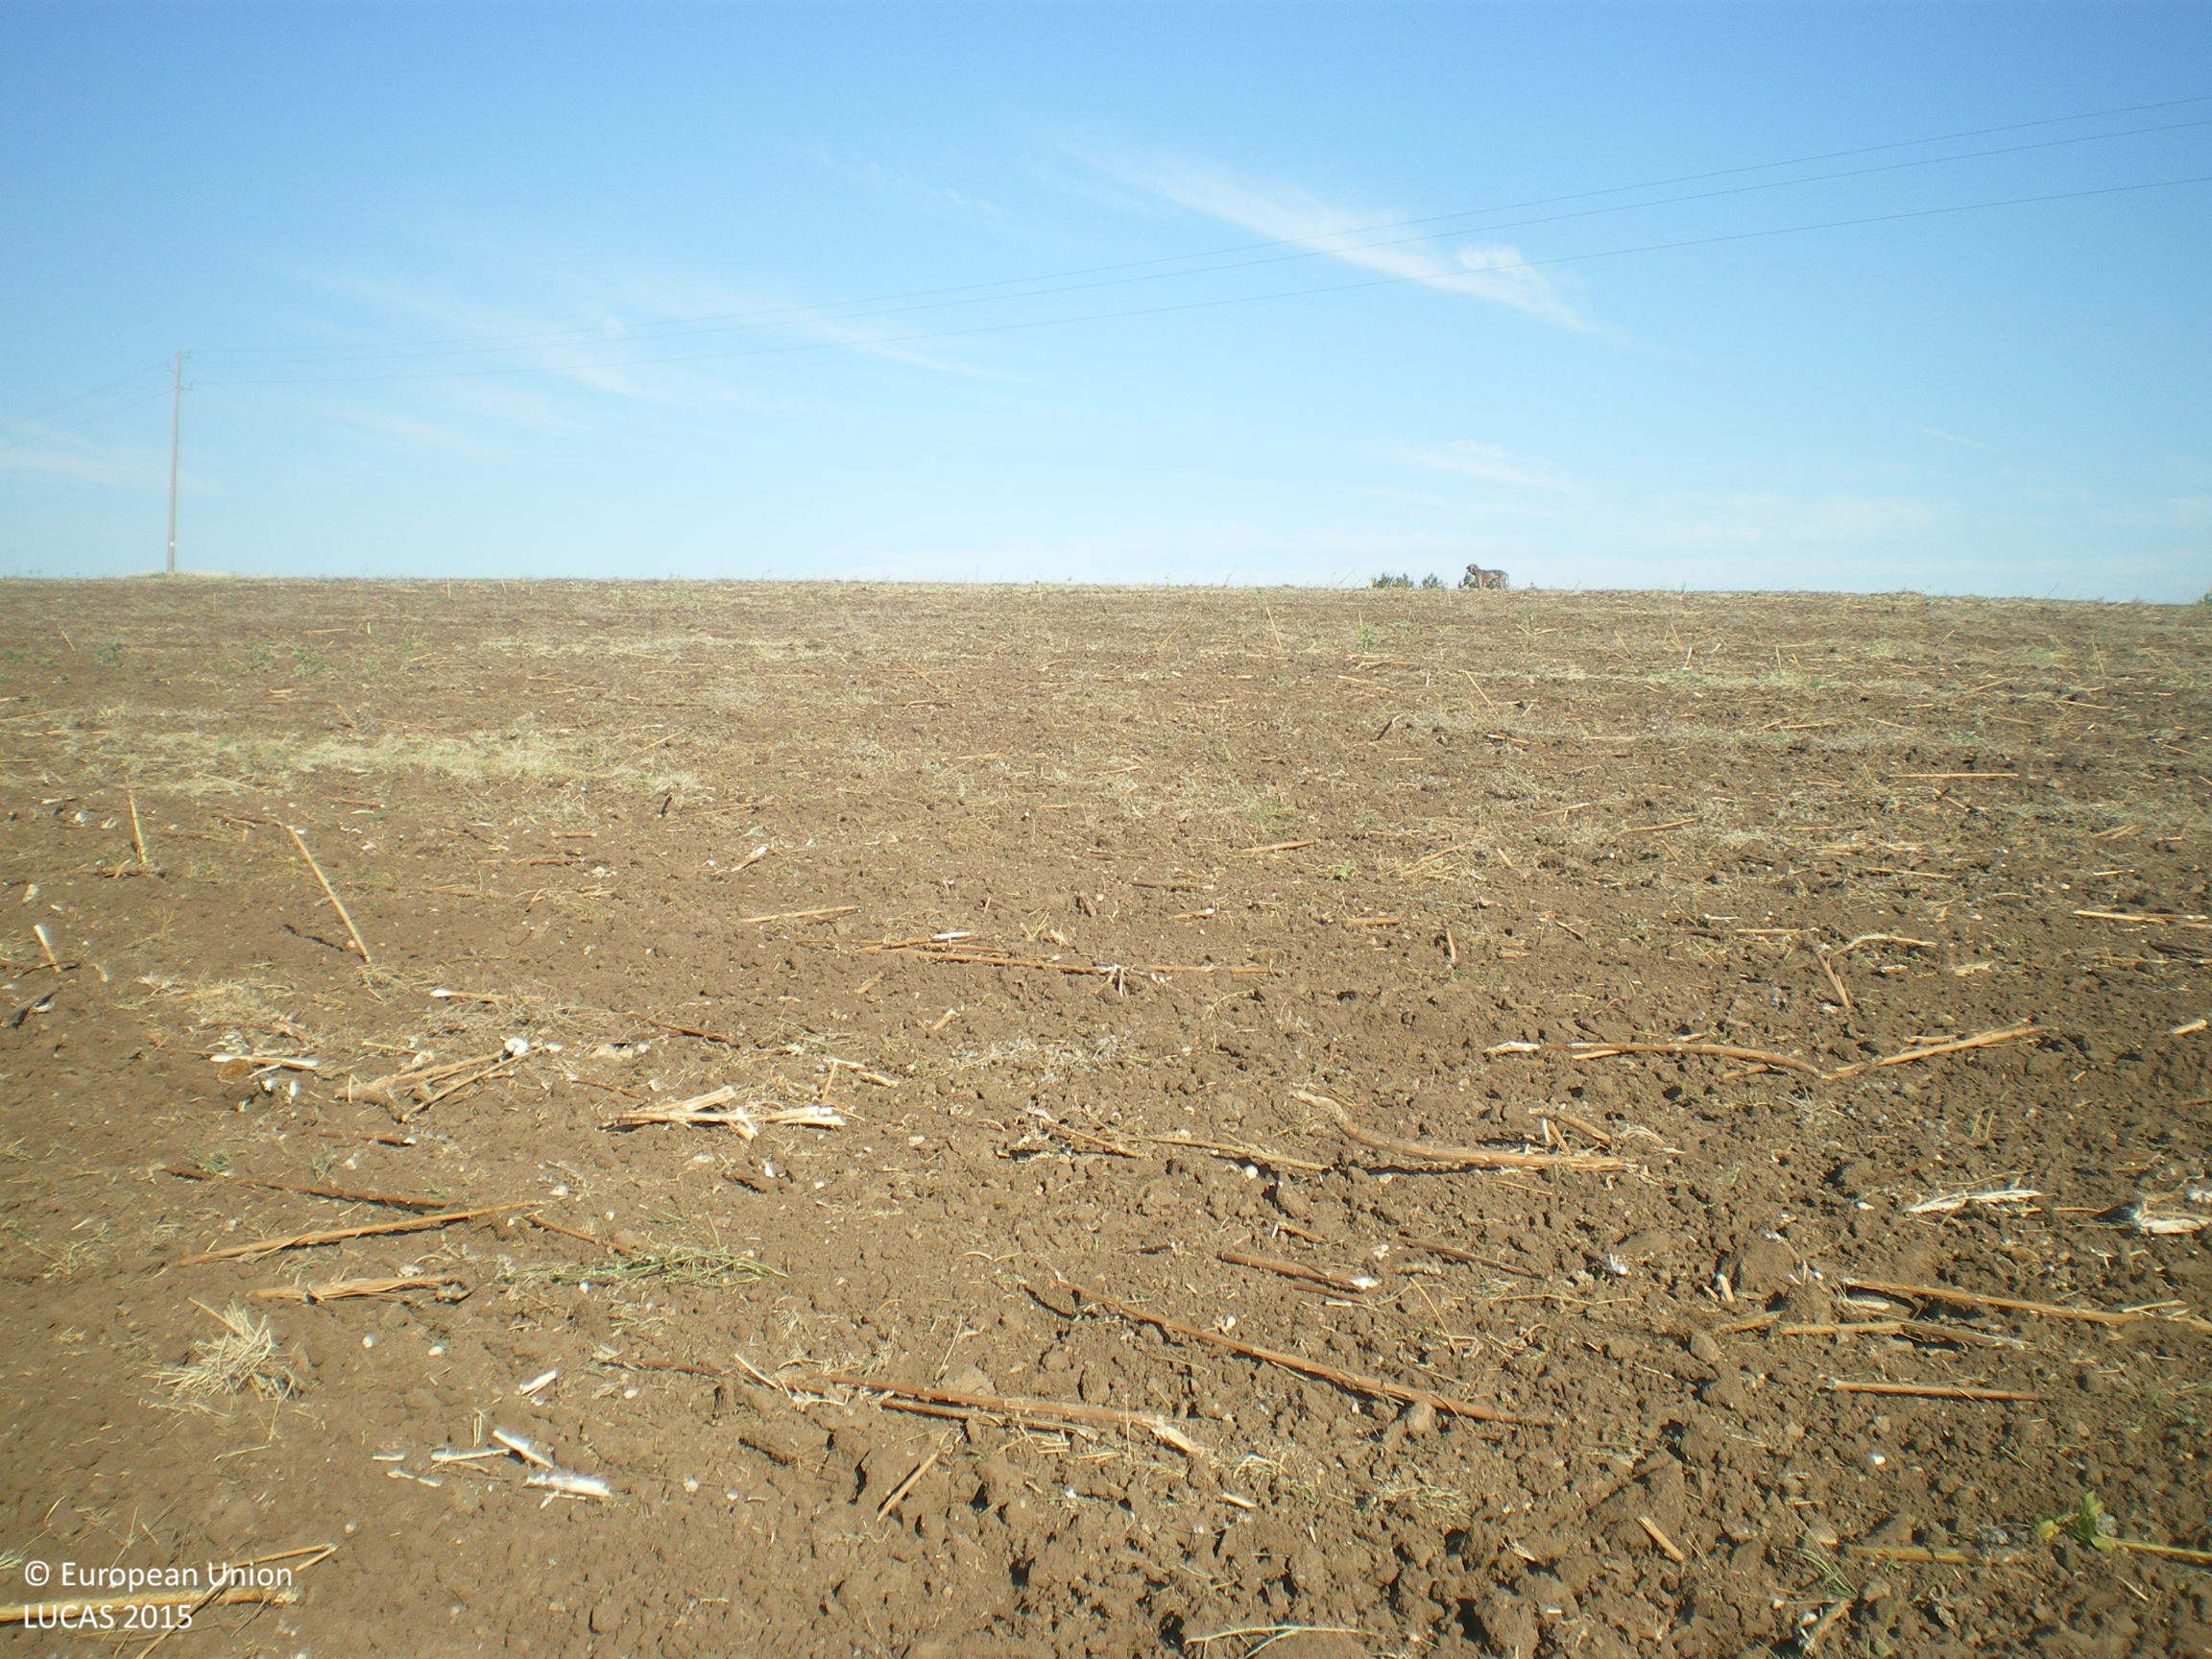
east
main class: Cropland
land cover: Sunflower
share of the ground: < 10 %
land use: Agriculture (excluding fallow land and kitchen gardens)
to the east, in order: Sunflower; Electric lines; Sunflower; Grass margins; Tracks; Shrubland without tree cover; Grassland without tree/shrub cover; Grassland with sparse tree/shrub cover
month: September
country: BG
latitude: 41.8205
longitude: 26.2951
